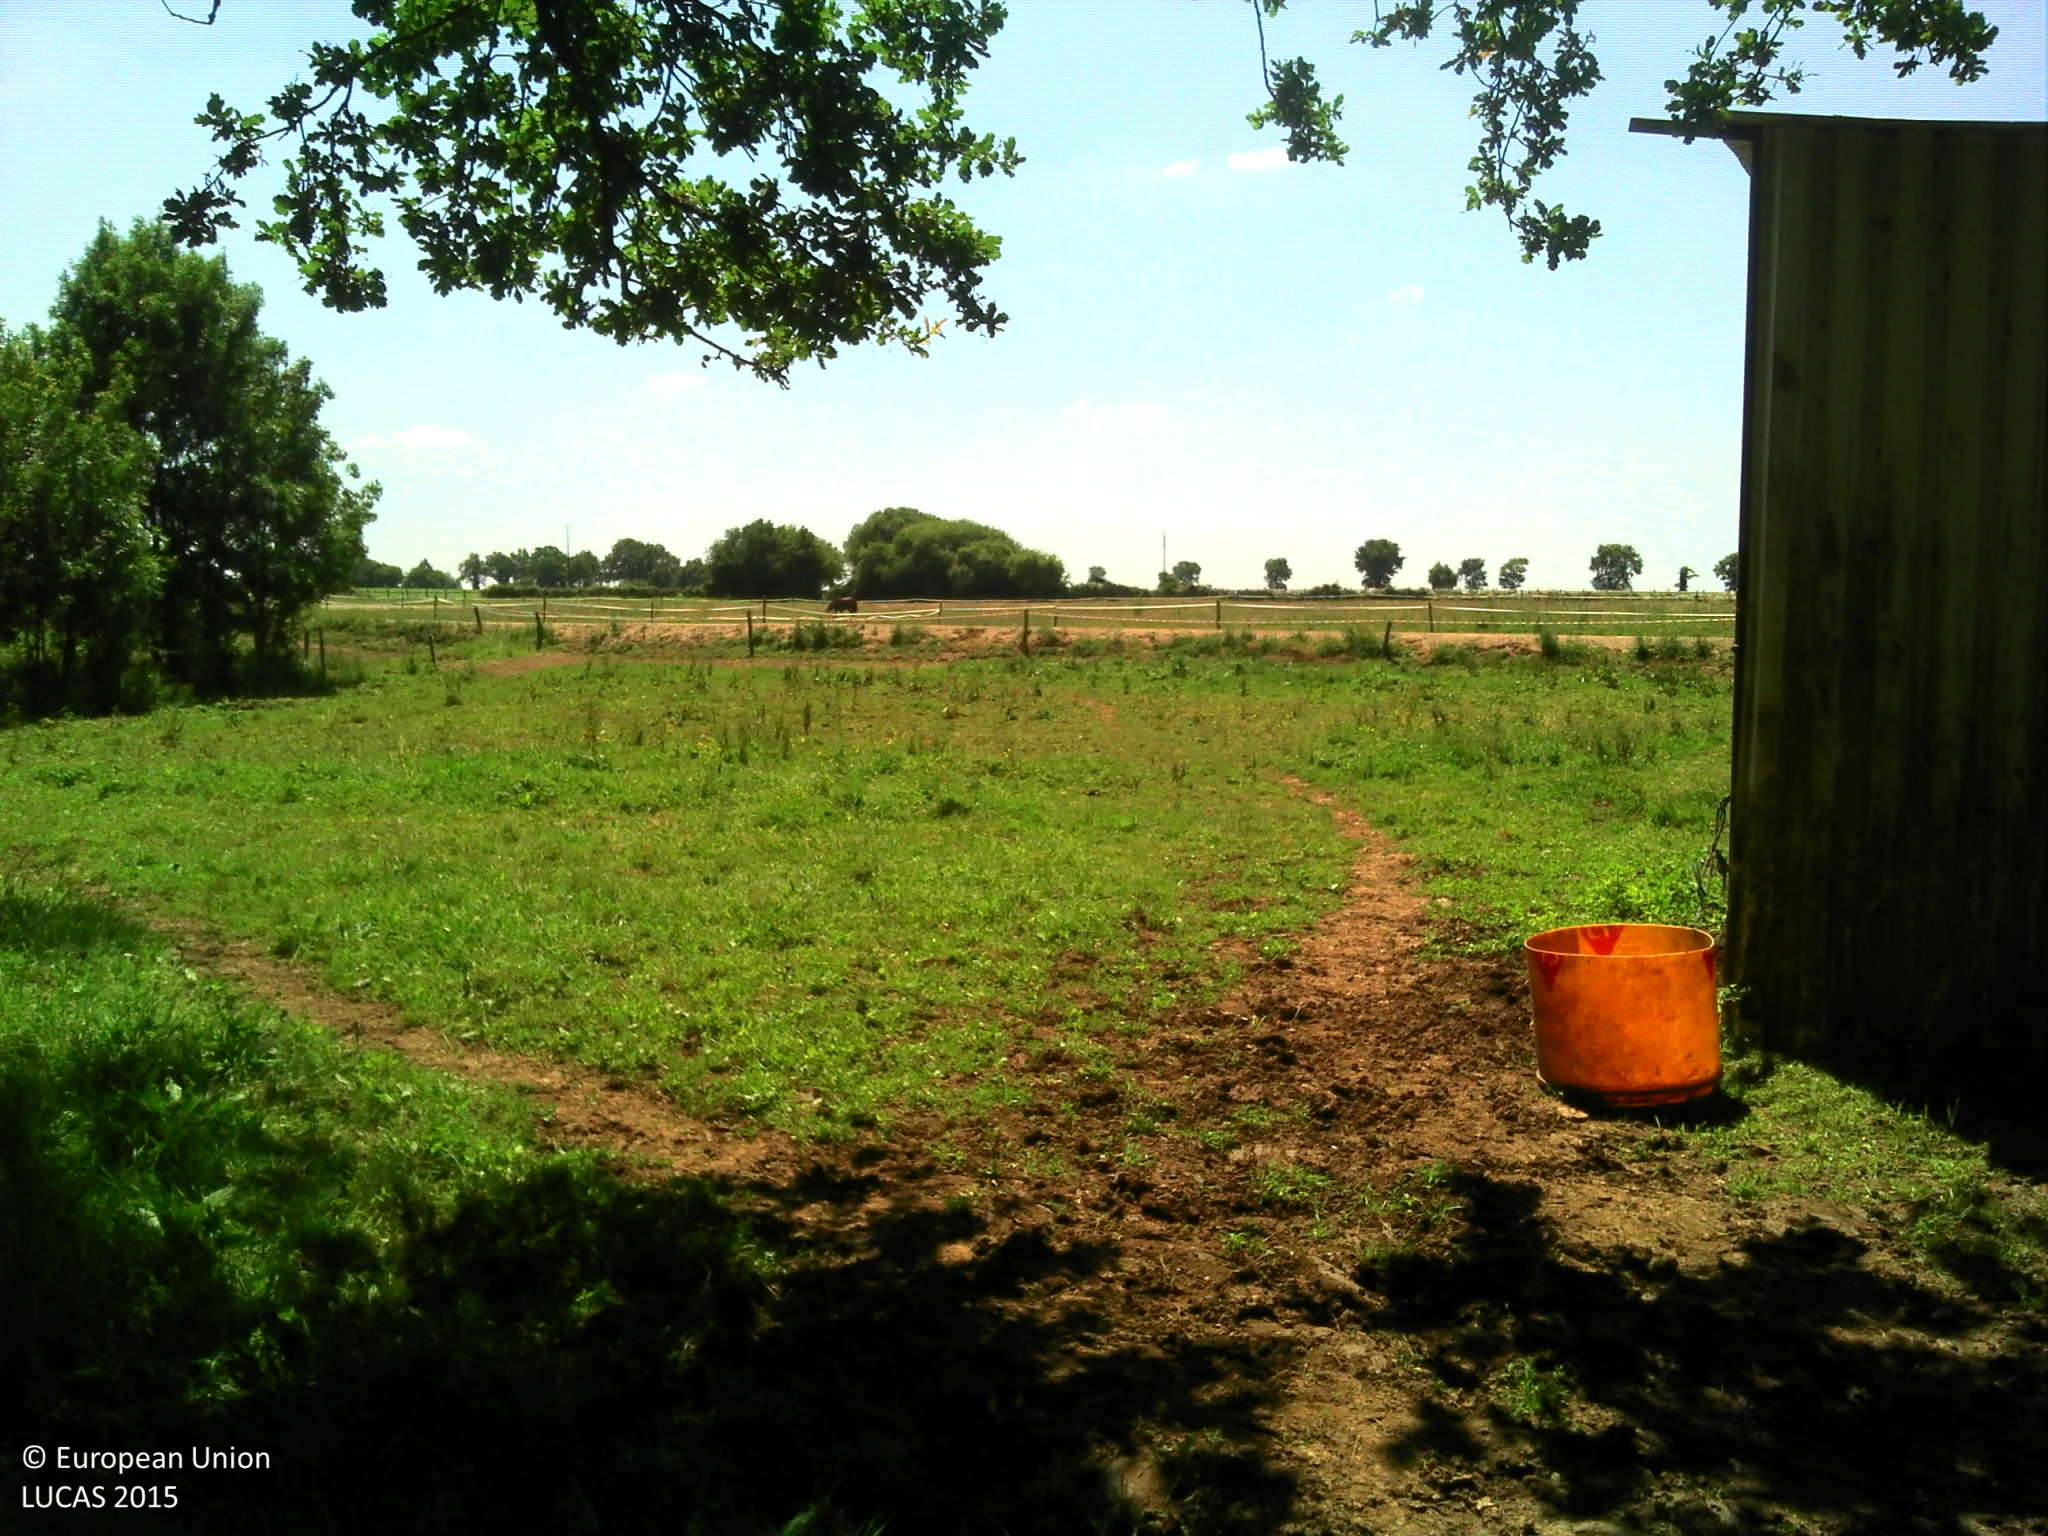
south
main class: Grassland
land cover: Grassland without tree/shrub cover
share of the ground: > 75 %
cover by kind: herbaceous plants 100 %
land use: Sport
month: June
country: FR
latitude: 46.8177
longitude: -1.3486
